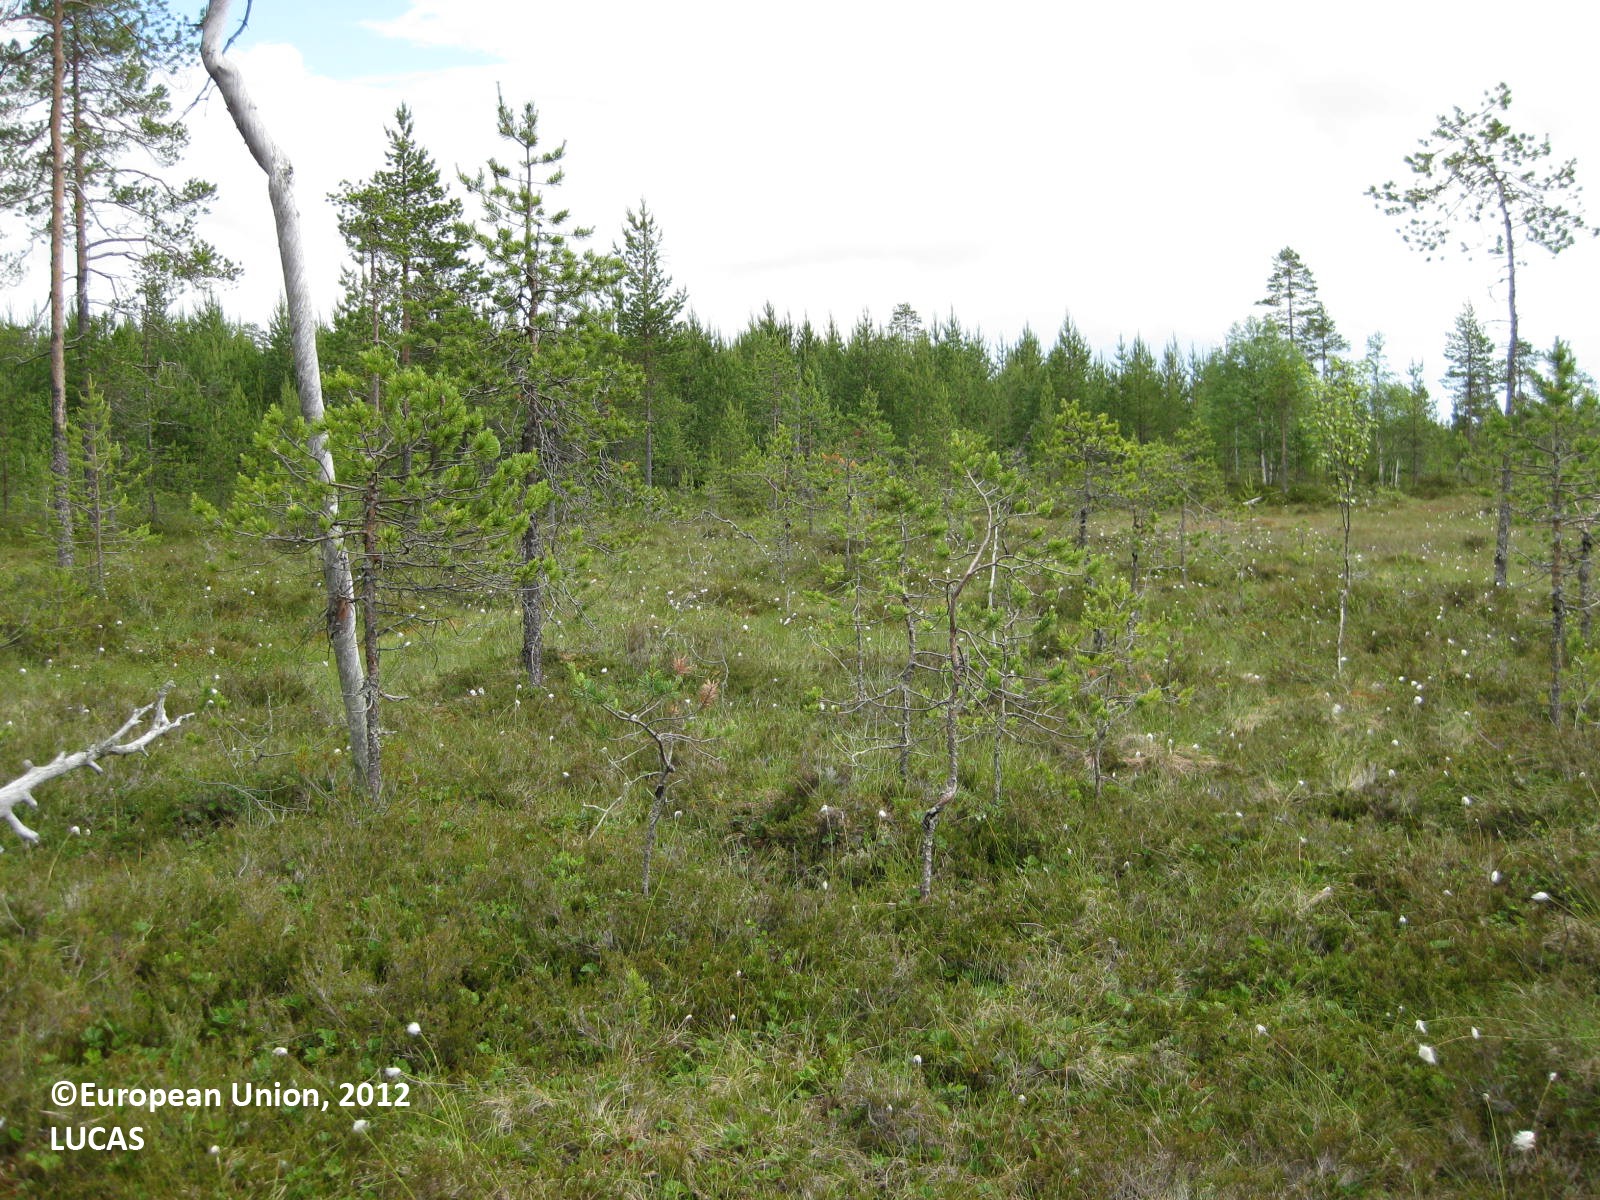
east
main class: Wetlands
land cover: Peatbogs
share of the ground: < 10 %
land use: Semi-natural and natural areas not in use
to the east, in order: Peatbogs; Pine dominated coniferous woodland; Ditches and canals; Pine dominated coniferous woodland; Ditches and canals; Pine dominated mixed woodland; Ditches and canals; Pine dominated mixed woodland; Ditches and canals; Pine dominated mixed woodland; Tracks; Abandoned hedges; Ditches and canals; Pine dominated coniferous woodland; Ditches and canals; Pine dominated coniferous woodland; Ditches and canals; Pine dominated coniferous woodland; Ditches and canals; Pine dominated mixed woodland; Ditches and canals; Pine dominated coniferous woodland; Ditches and canals; Pine dominated coniferous woodland; Ditches and canals; Pine dominated coniferous woodland; Ditches and canals; Pine dominated coniferous woodland; Ditches and canals; Pine dominated coniferous woodland; Ditches and canals; Pine dominated coniferous woodland; Ditches and canals; Pine dominated coniferous woodland; Ditches and canals; Pine dominated coniferous woodland; Ditches and canals; Pine dominated coniferous woodland; Ditches and canals; Pine dominated coniferous woodland; Ditches and canals; Pine dominated coniferous woodland; Ditches and canals; Pine dominated coniferous woodland; Ditches and canals; Pine dominated coniferous woodland; Ditches and canals; Pine dominated coniferous woodland; Ditches and canals; Pine dominated coniferous woodland; Ditches and canals; Pine dominated coniferous woodland; Ditches and canals; Pine dominated coniferous woodland; Ditches and canals; Pine dominated coniferous woodland; Ditches and canals; Pine dominated coniferous woodland; Ditches and canals; Pine dominated coniferous woodland; Ditches and canals; Pine dominated coniferous woodland; Ditches and canals; Pine dominated coniferous woodland; Ditches and canals; Pine dominated coniferous woodland
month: July
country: FI
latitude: 65.4436
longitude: 28.3359
